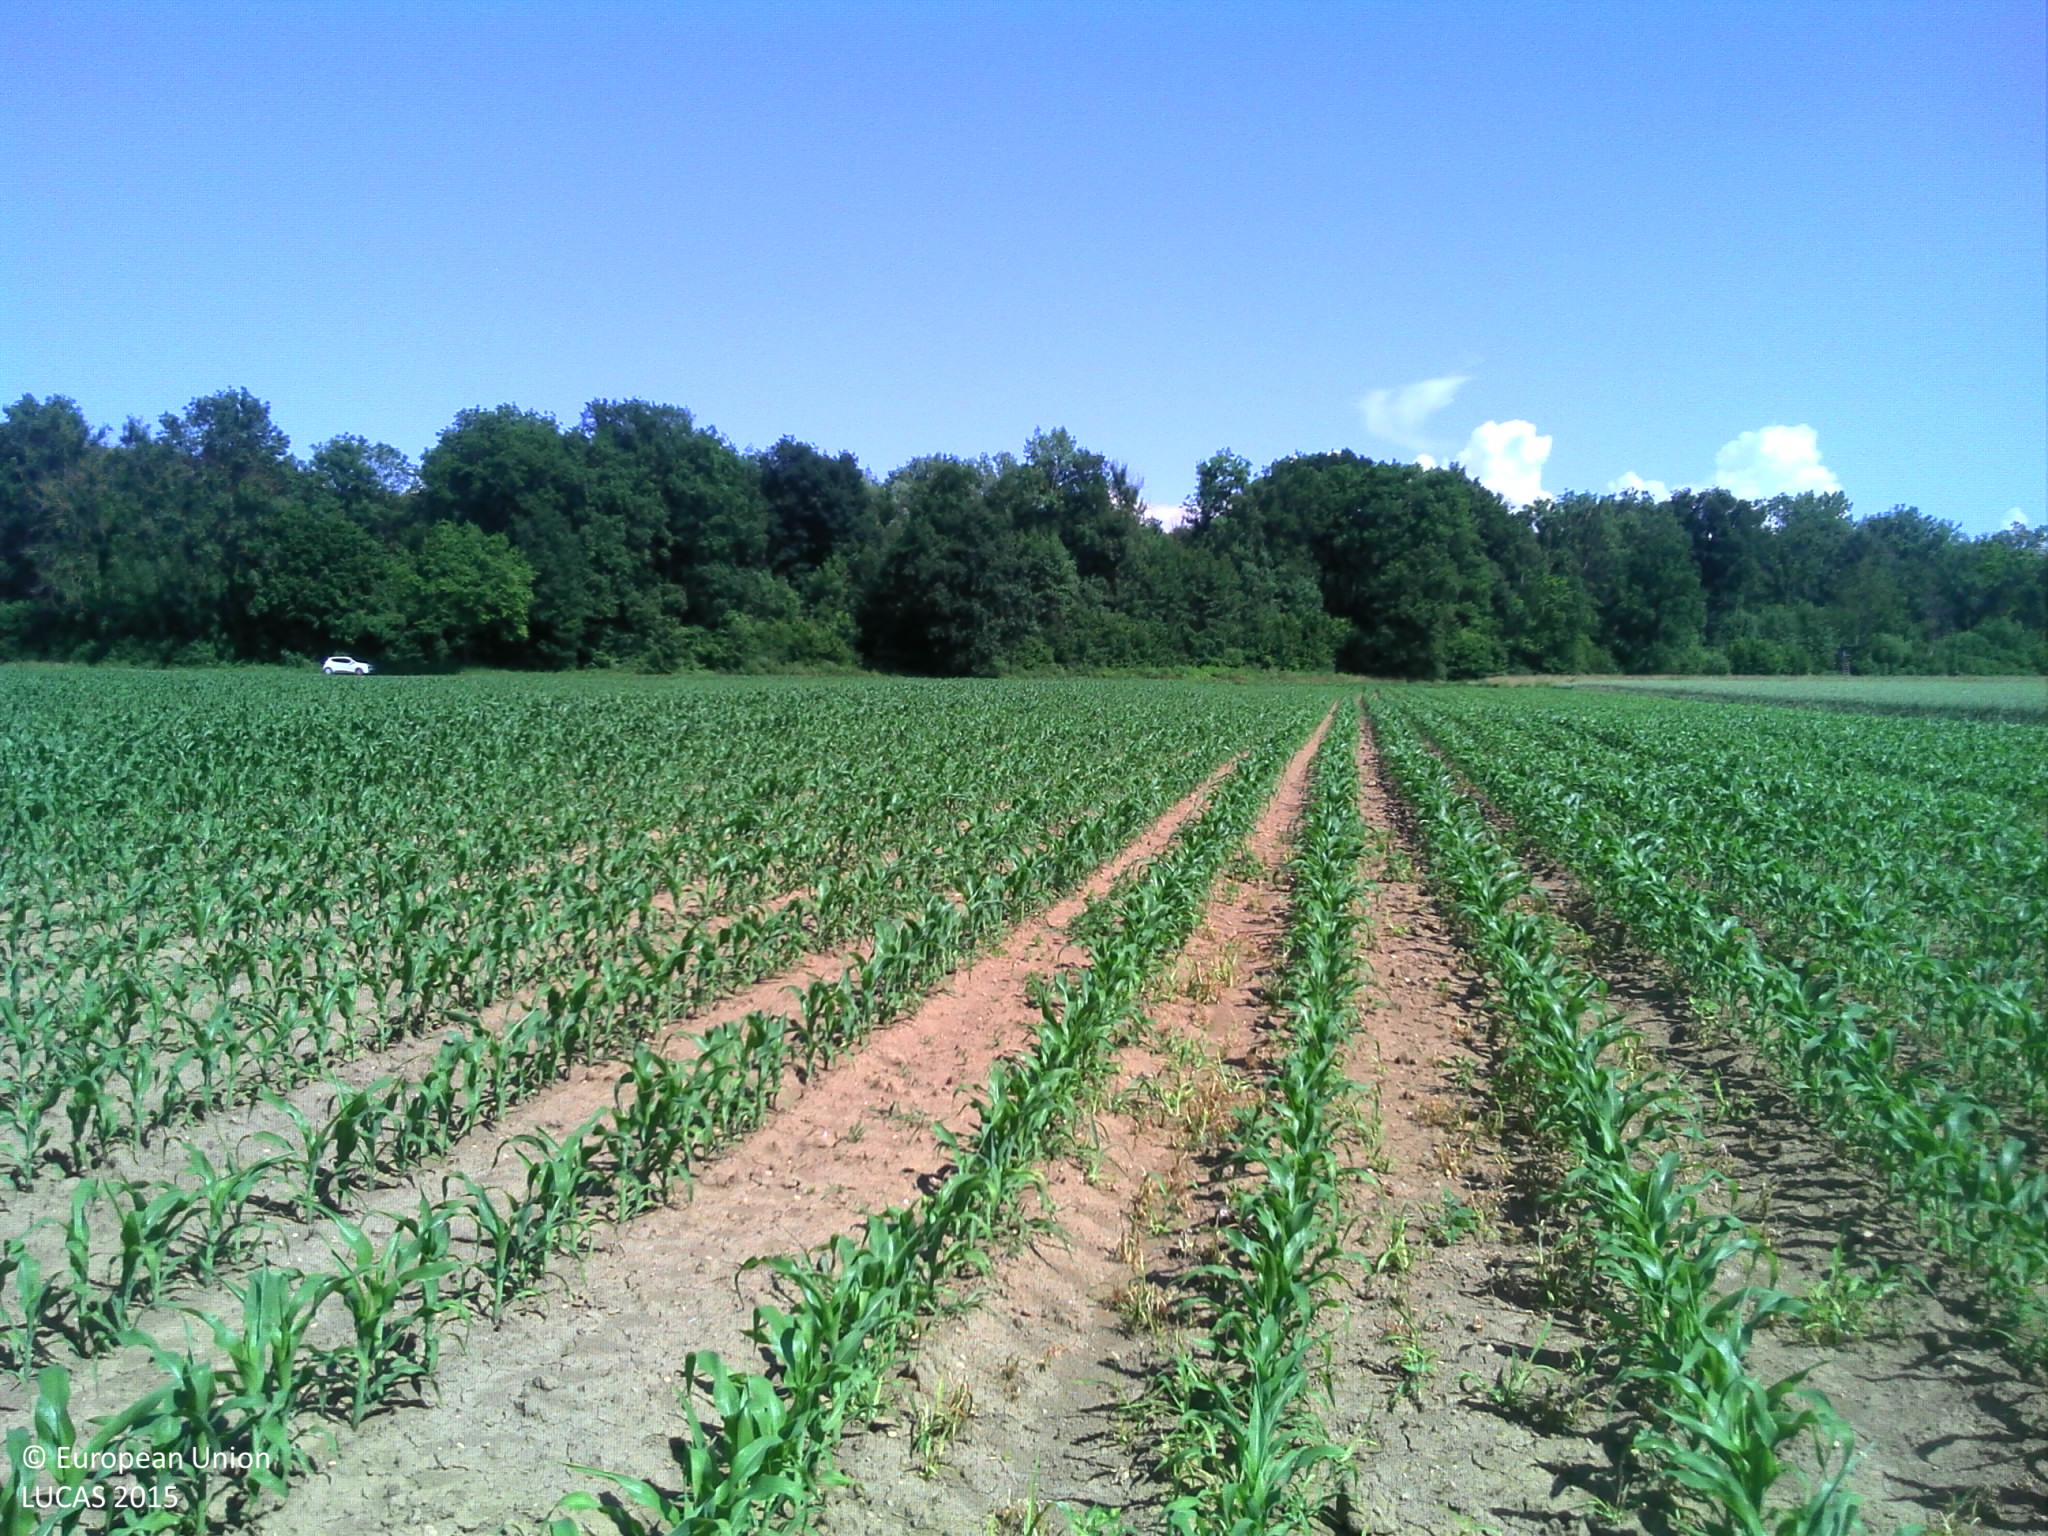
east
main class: Cropland
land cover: Maize
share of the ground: 10 - 25 %
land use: Agriculture (excluding fallow land and kitchen gardens)
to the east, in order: Maize; Grass margins; Tracks; Grass margins; Broadleaved woodland
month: June
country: FR
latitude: 48.4496
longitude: 7.6078
